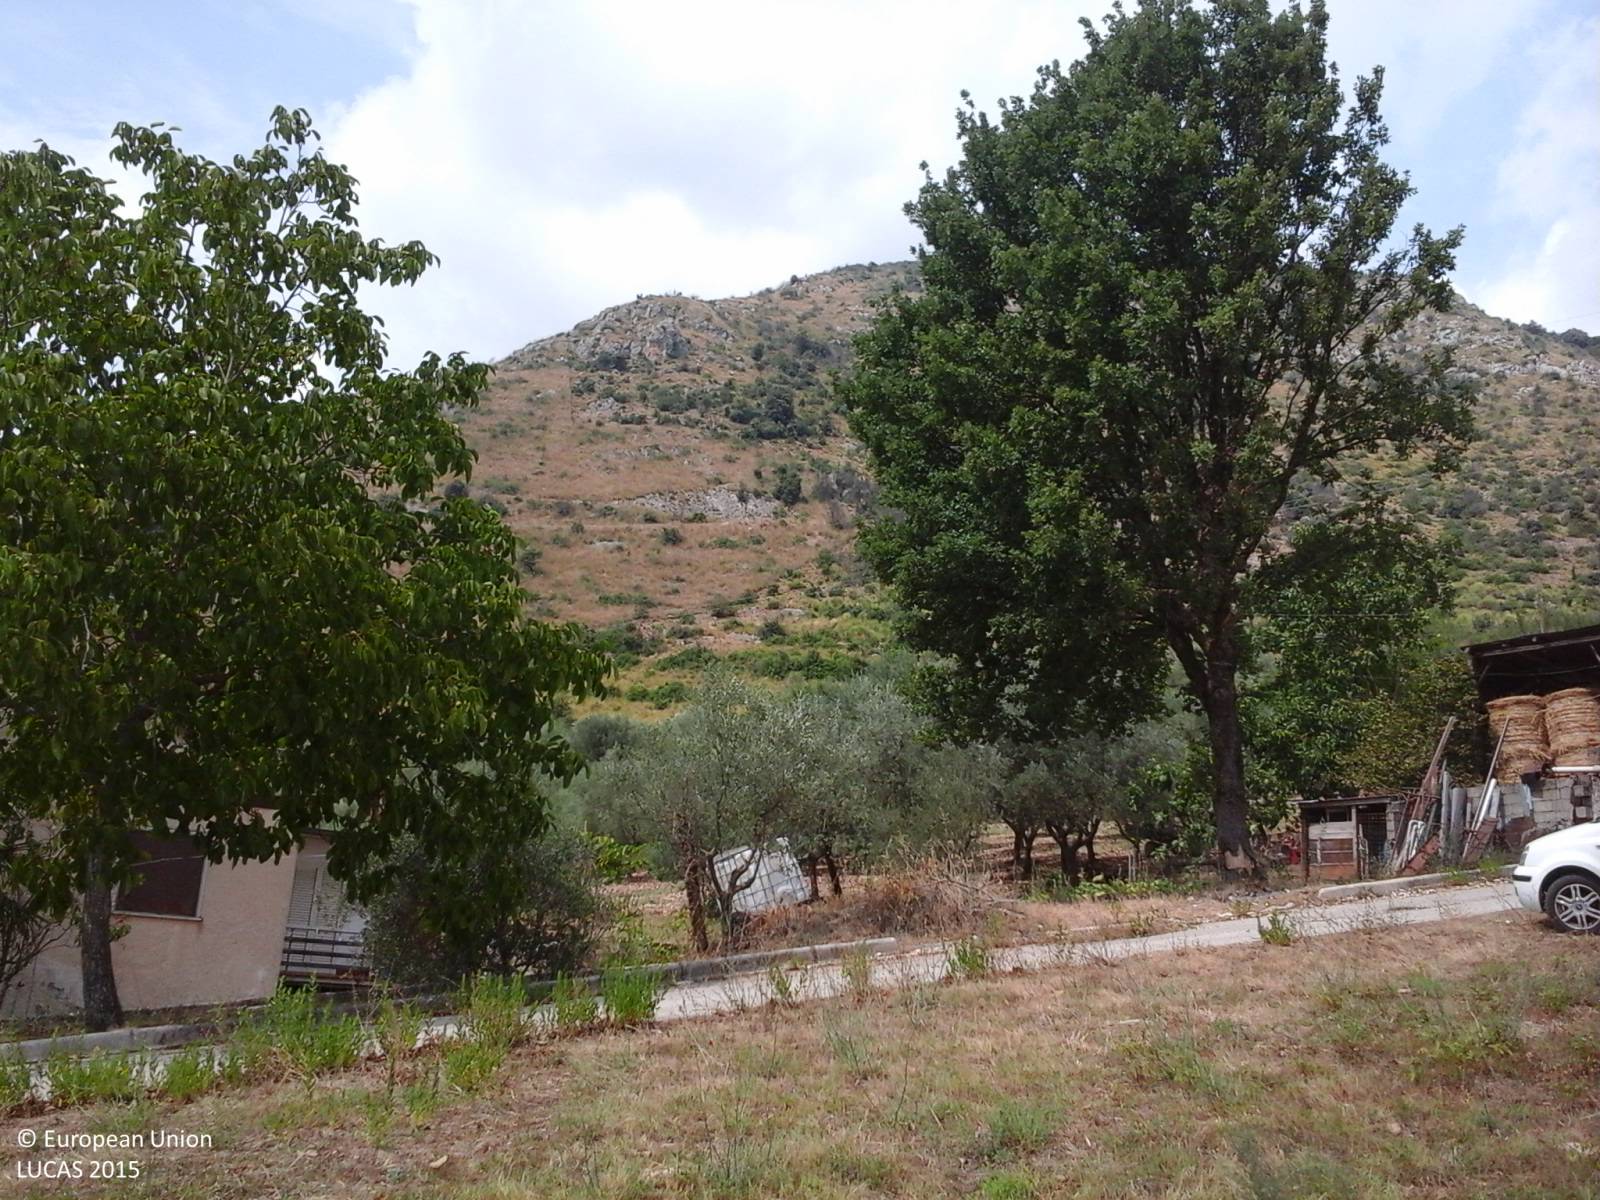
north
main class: Grassland
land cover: Grassland without tree/shrub cover
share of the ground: > 75 %
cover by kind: herbaceous plants 100 %
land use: Abandoned areas
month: August
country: IT
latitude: 41.5189
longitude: 13.7127
